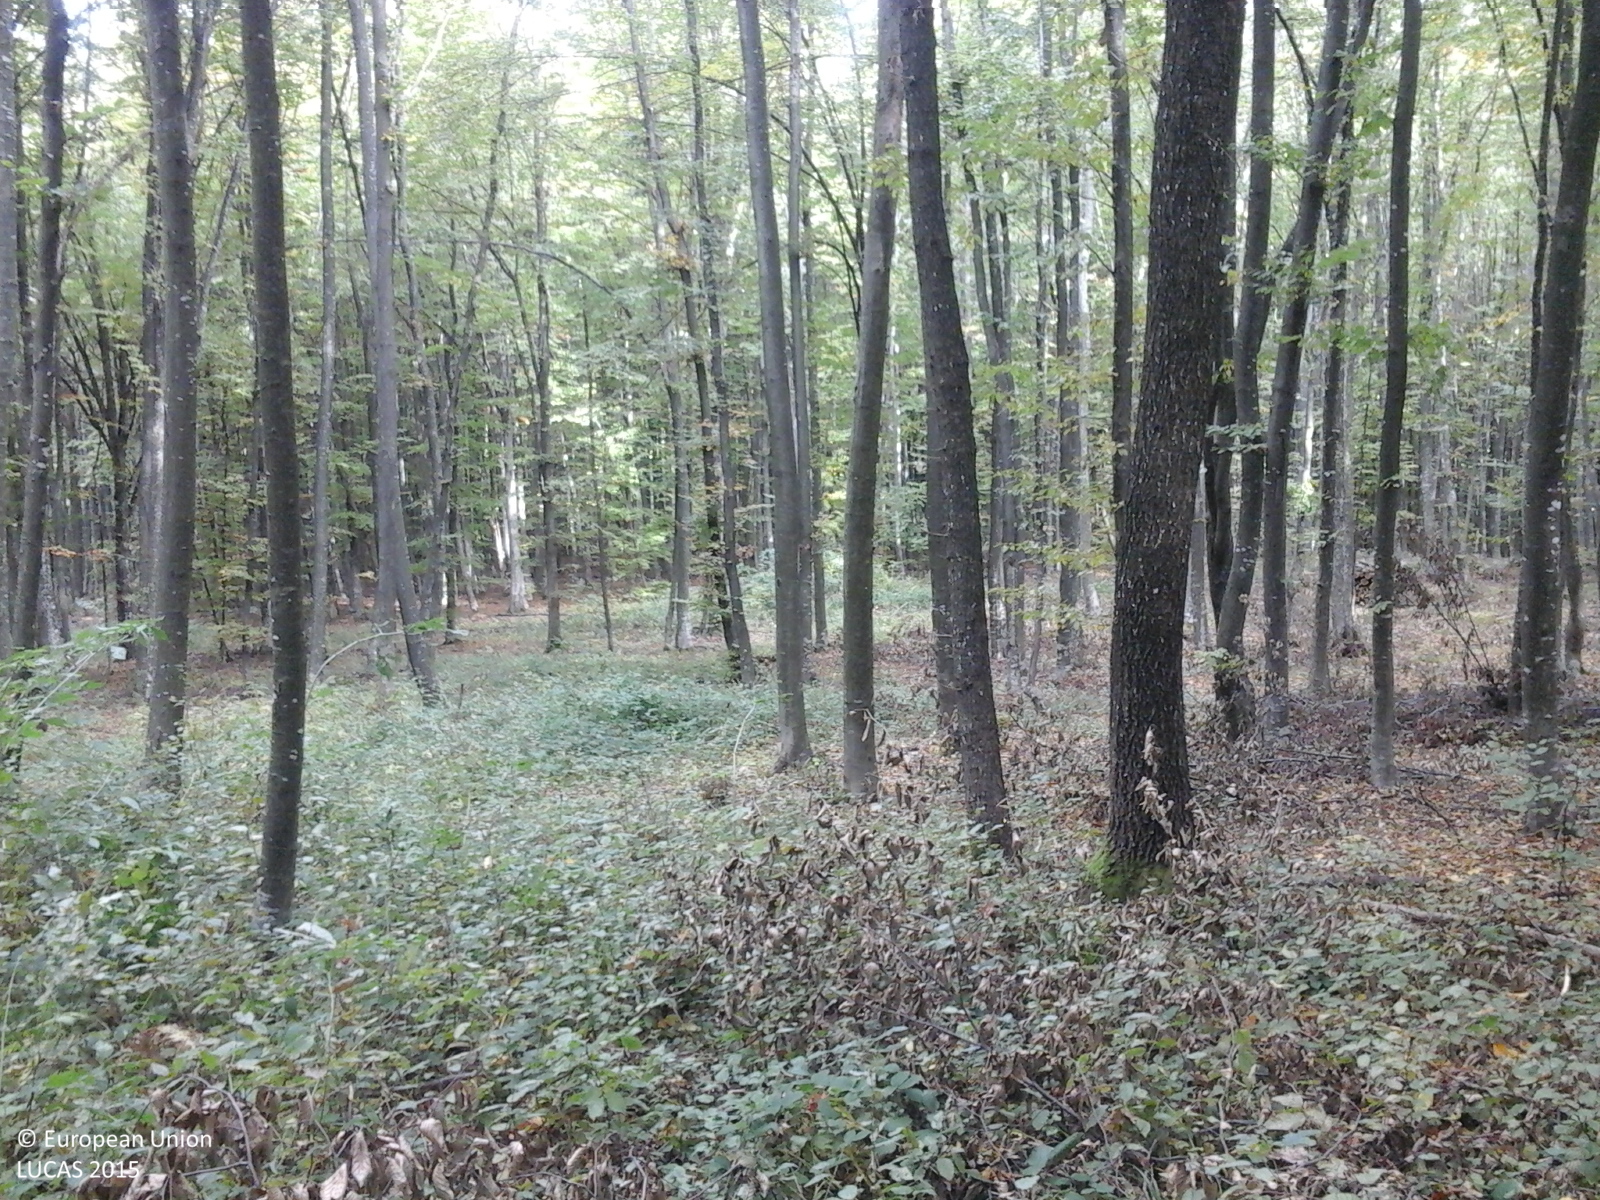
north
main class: Woodland
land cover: Broadleaved woodland
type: beech forest
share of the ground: > 75 %
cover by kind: broadleaved forest trees 100 %
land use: Forestry
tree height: > 5 m
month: October
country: RO
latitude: 46.4599
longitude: 25.1125
